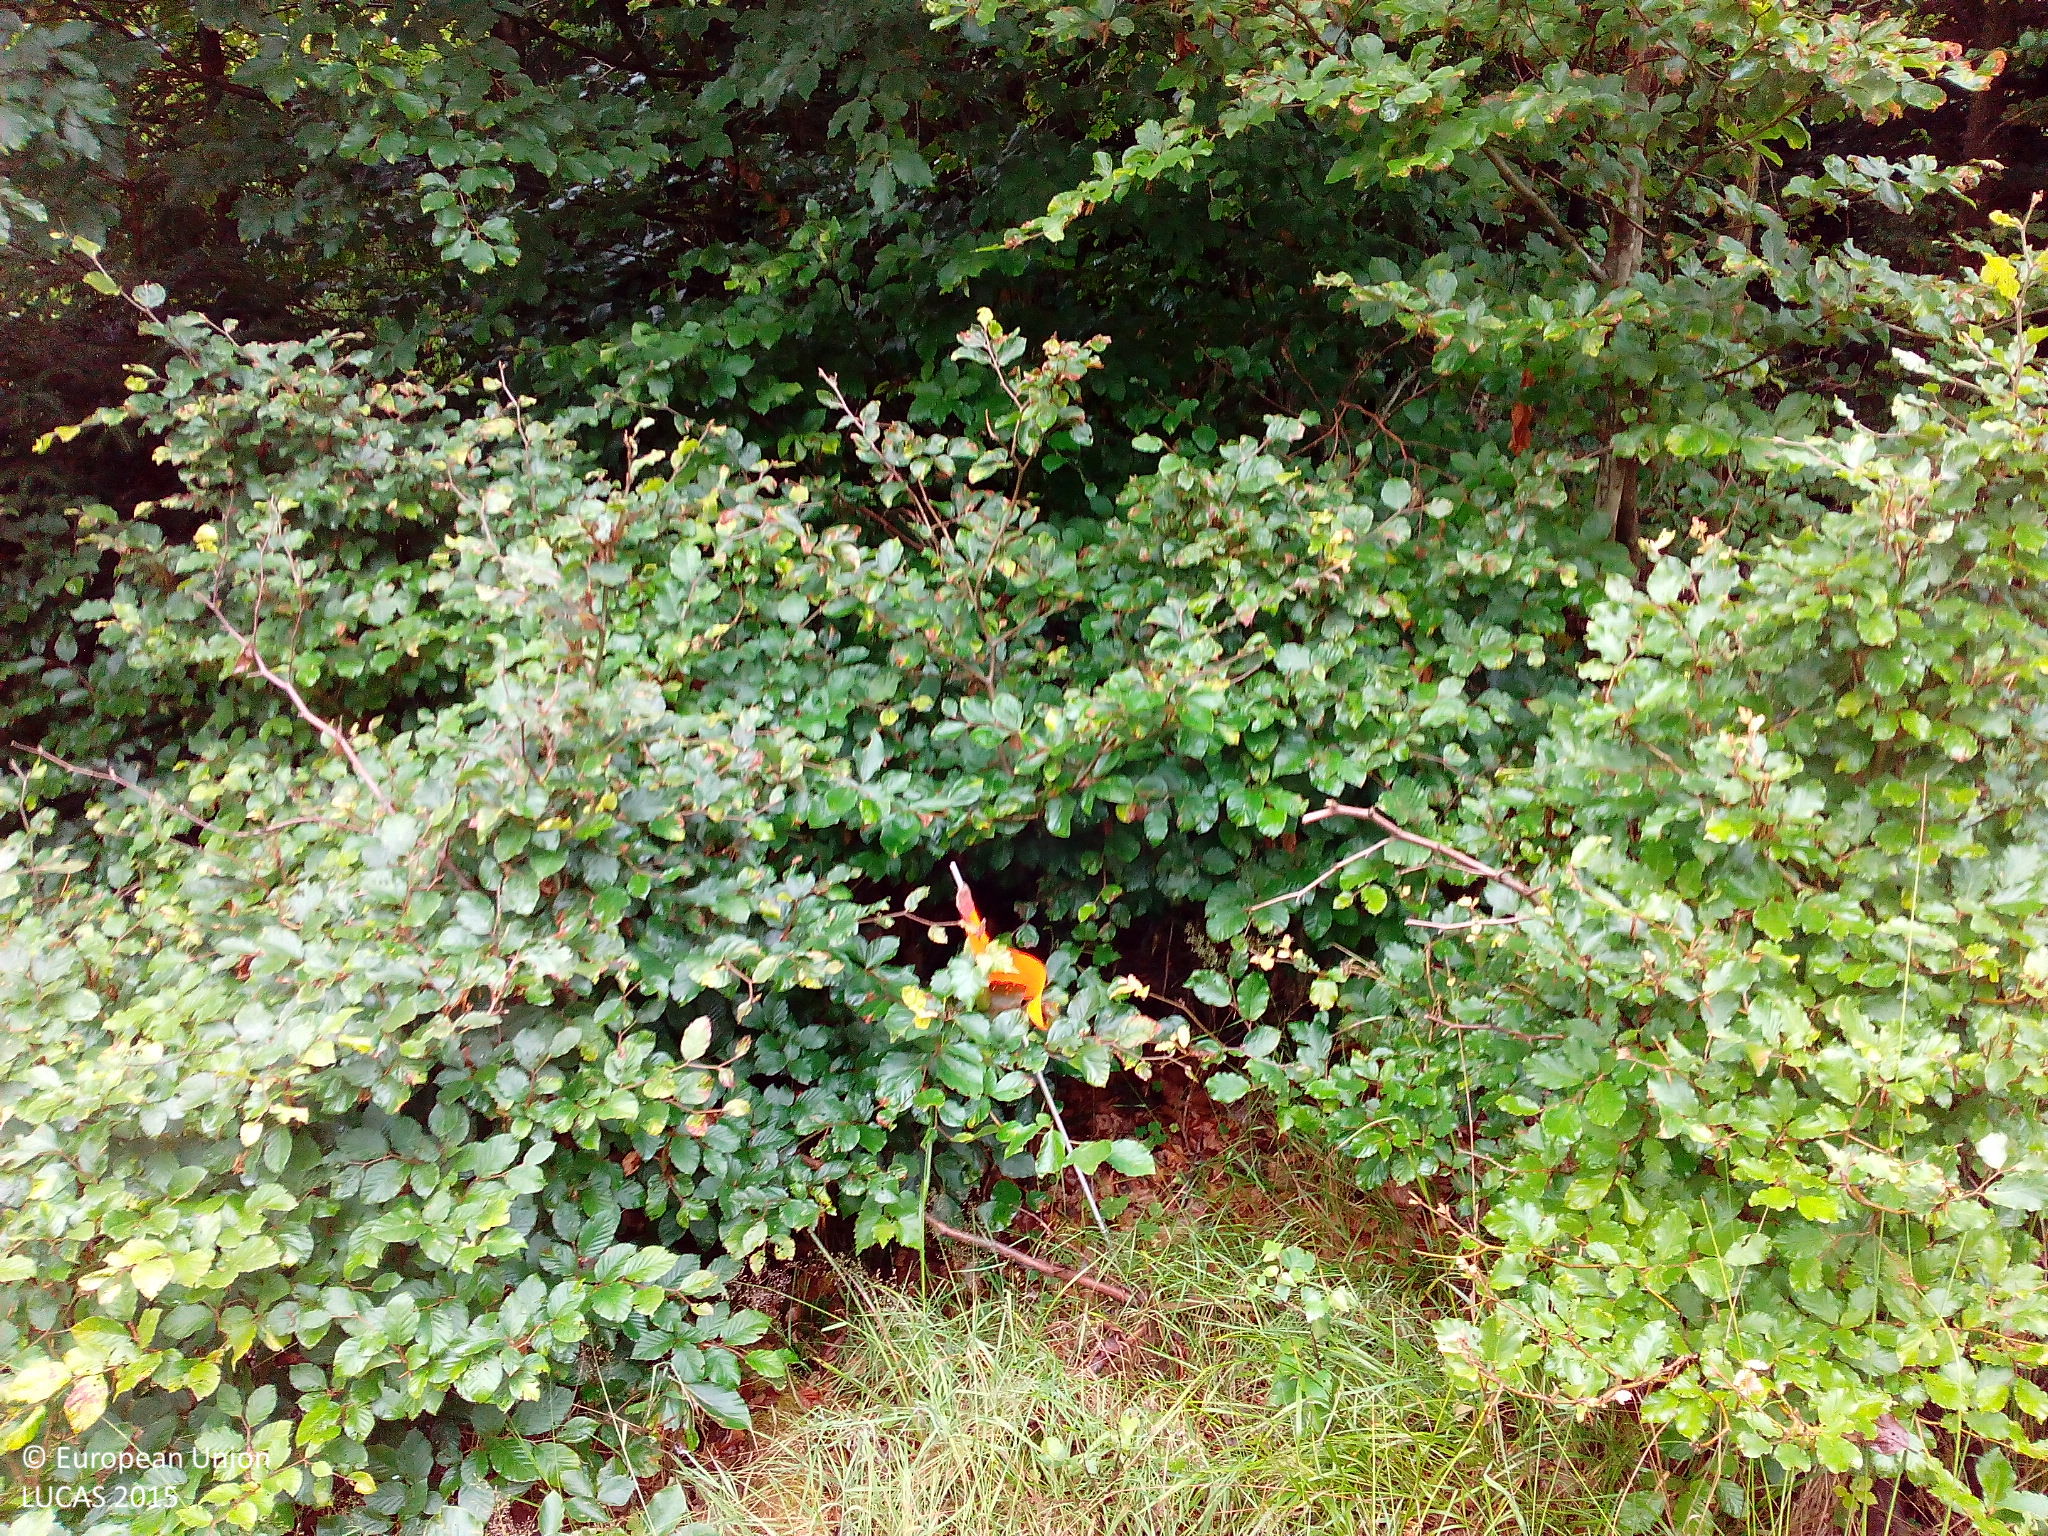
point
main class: Woodland
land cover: Broadleaved woodland
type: beech forest
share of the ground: > 75 %
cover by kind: broadleaved forest trees 95 %, herbaceous plants 5 %
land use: Forestry
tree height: > 5 m
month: July
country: DE
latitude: 50.9034
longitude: 9.9005
